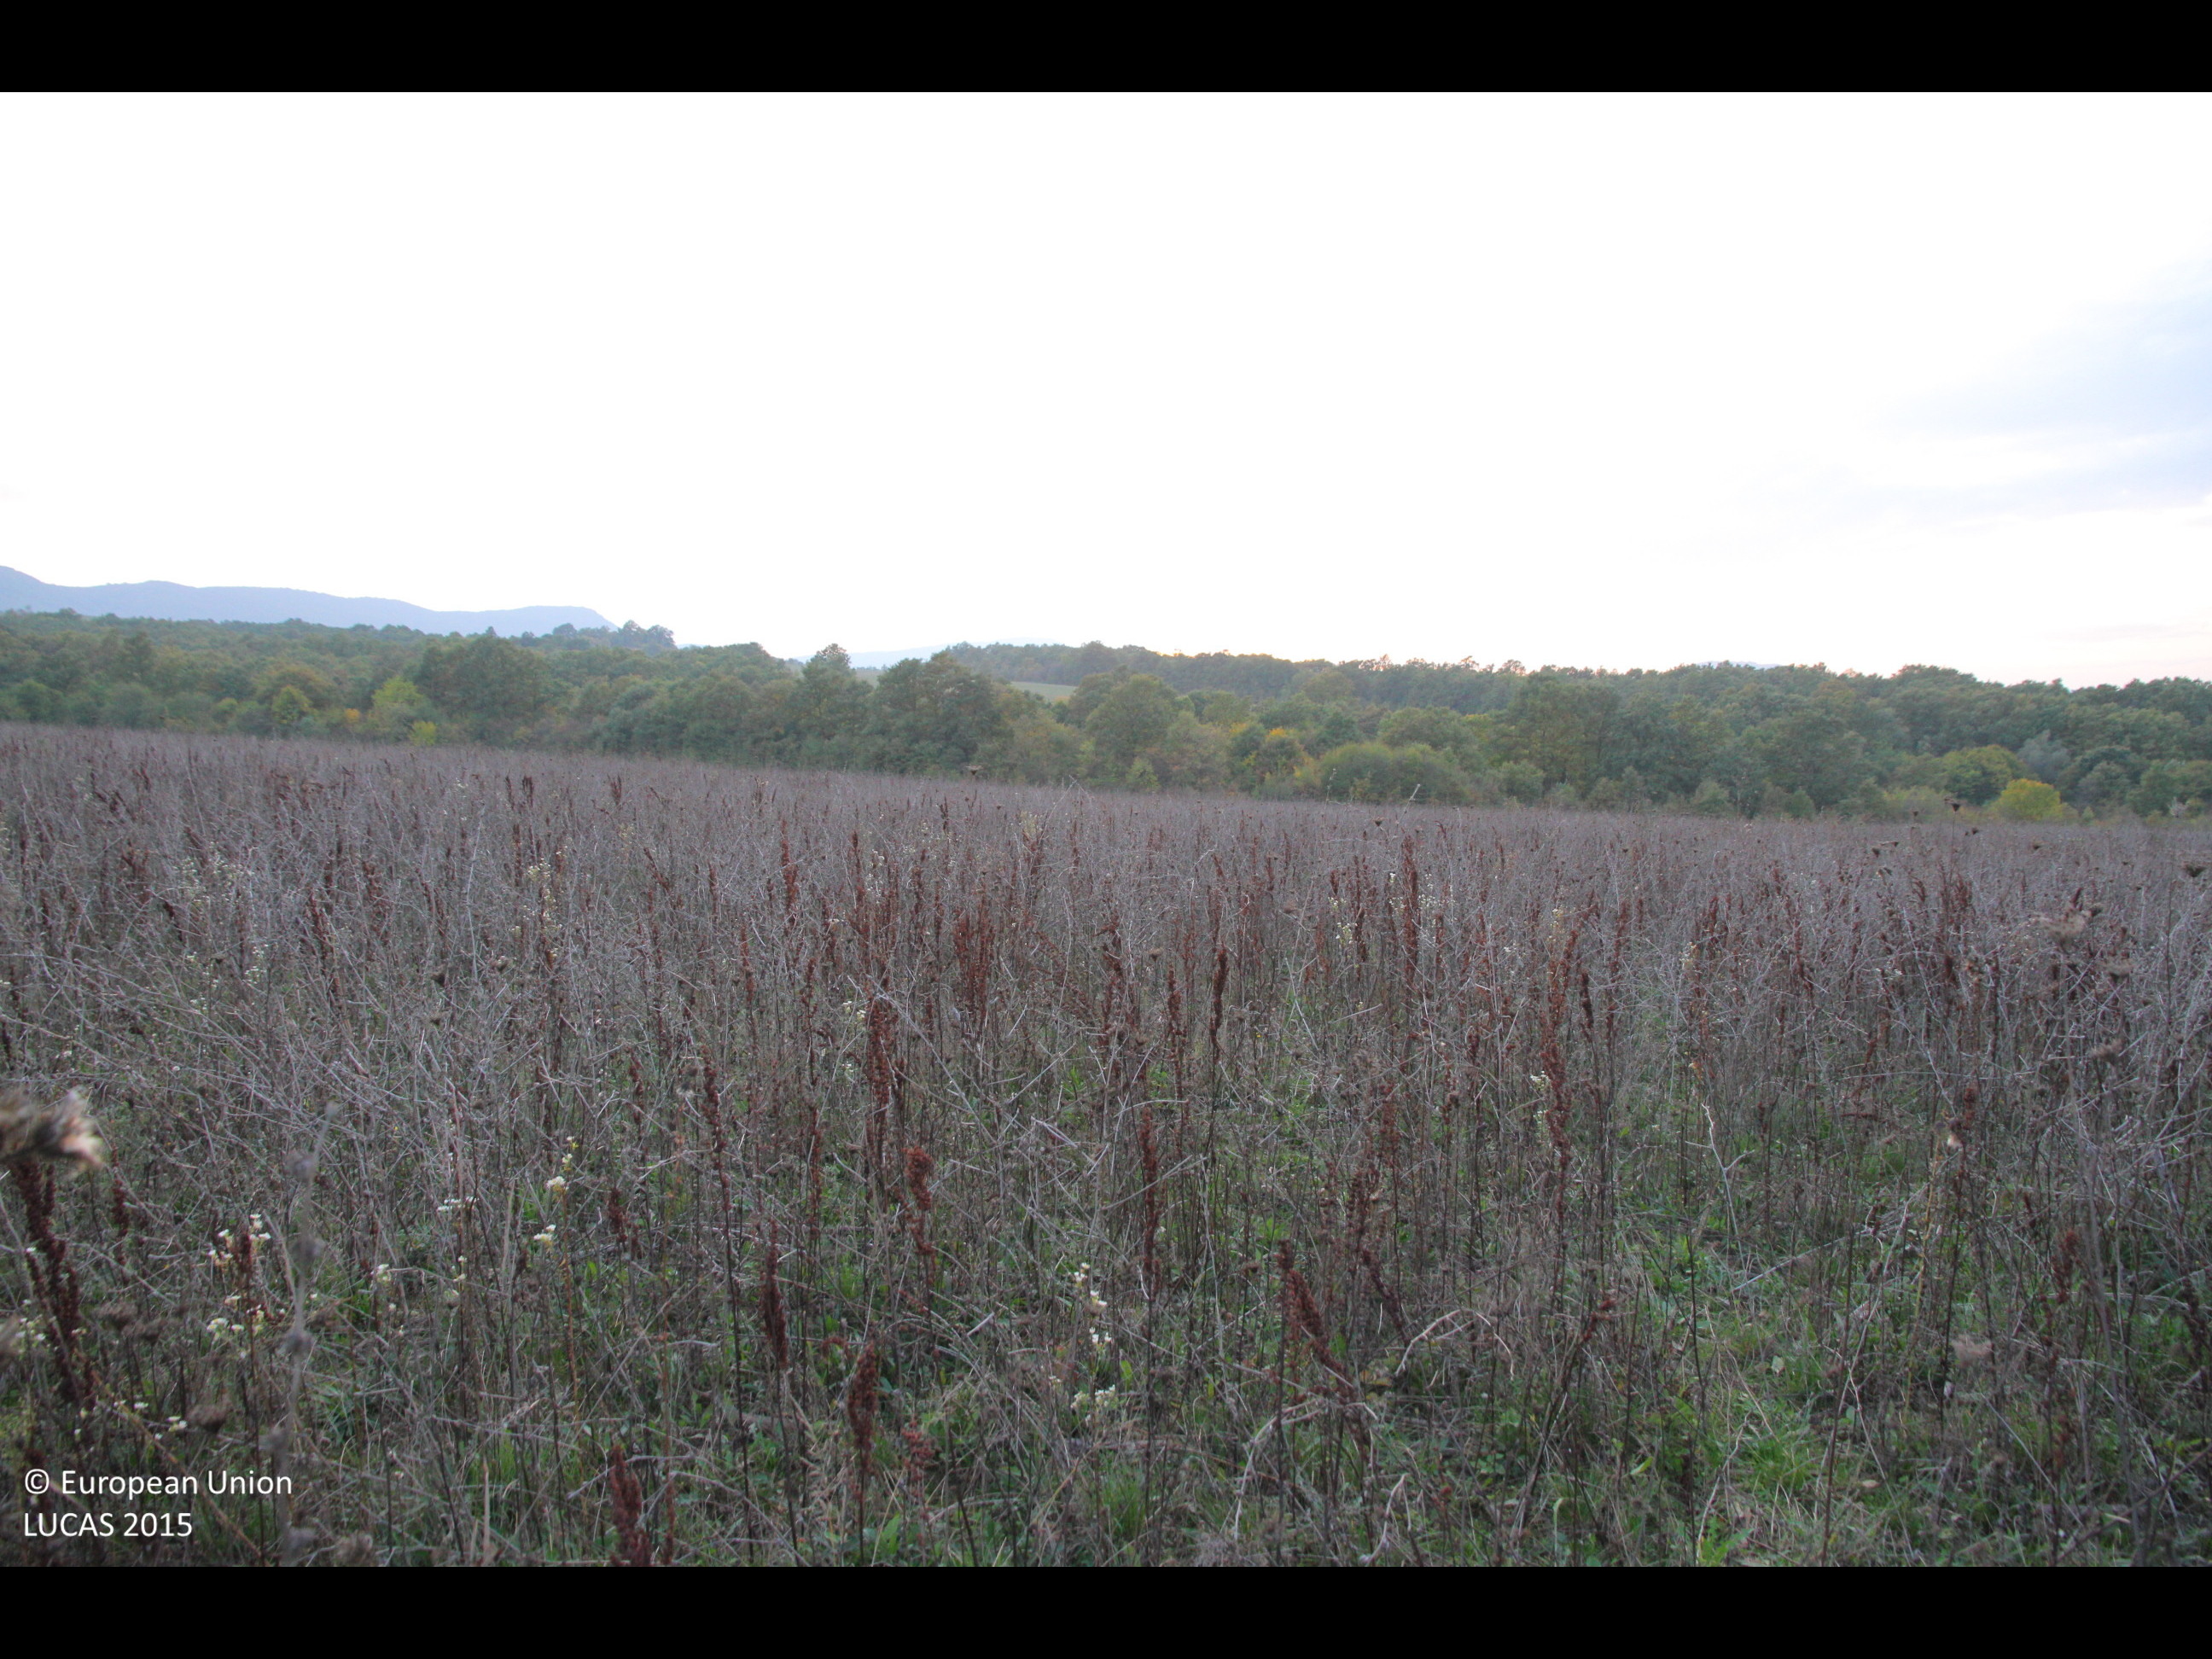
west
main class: Grassland
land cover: Spontaneously vegetated surfaces
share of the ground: > 75 %
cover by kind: herbaceous plants 100 %
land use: Agriculture (excluding fallow land and kitchen gardens)
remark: Harvested field
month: October
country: BG
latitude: 42.9729
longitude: 26.9946
